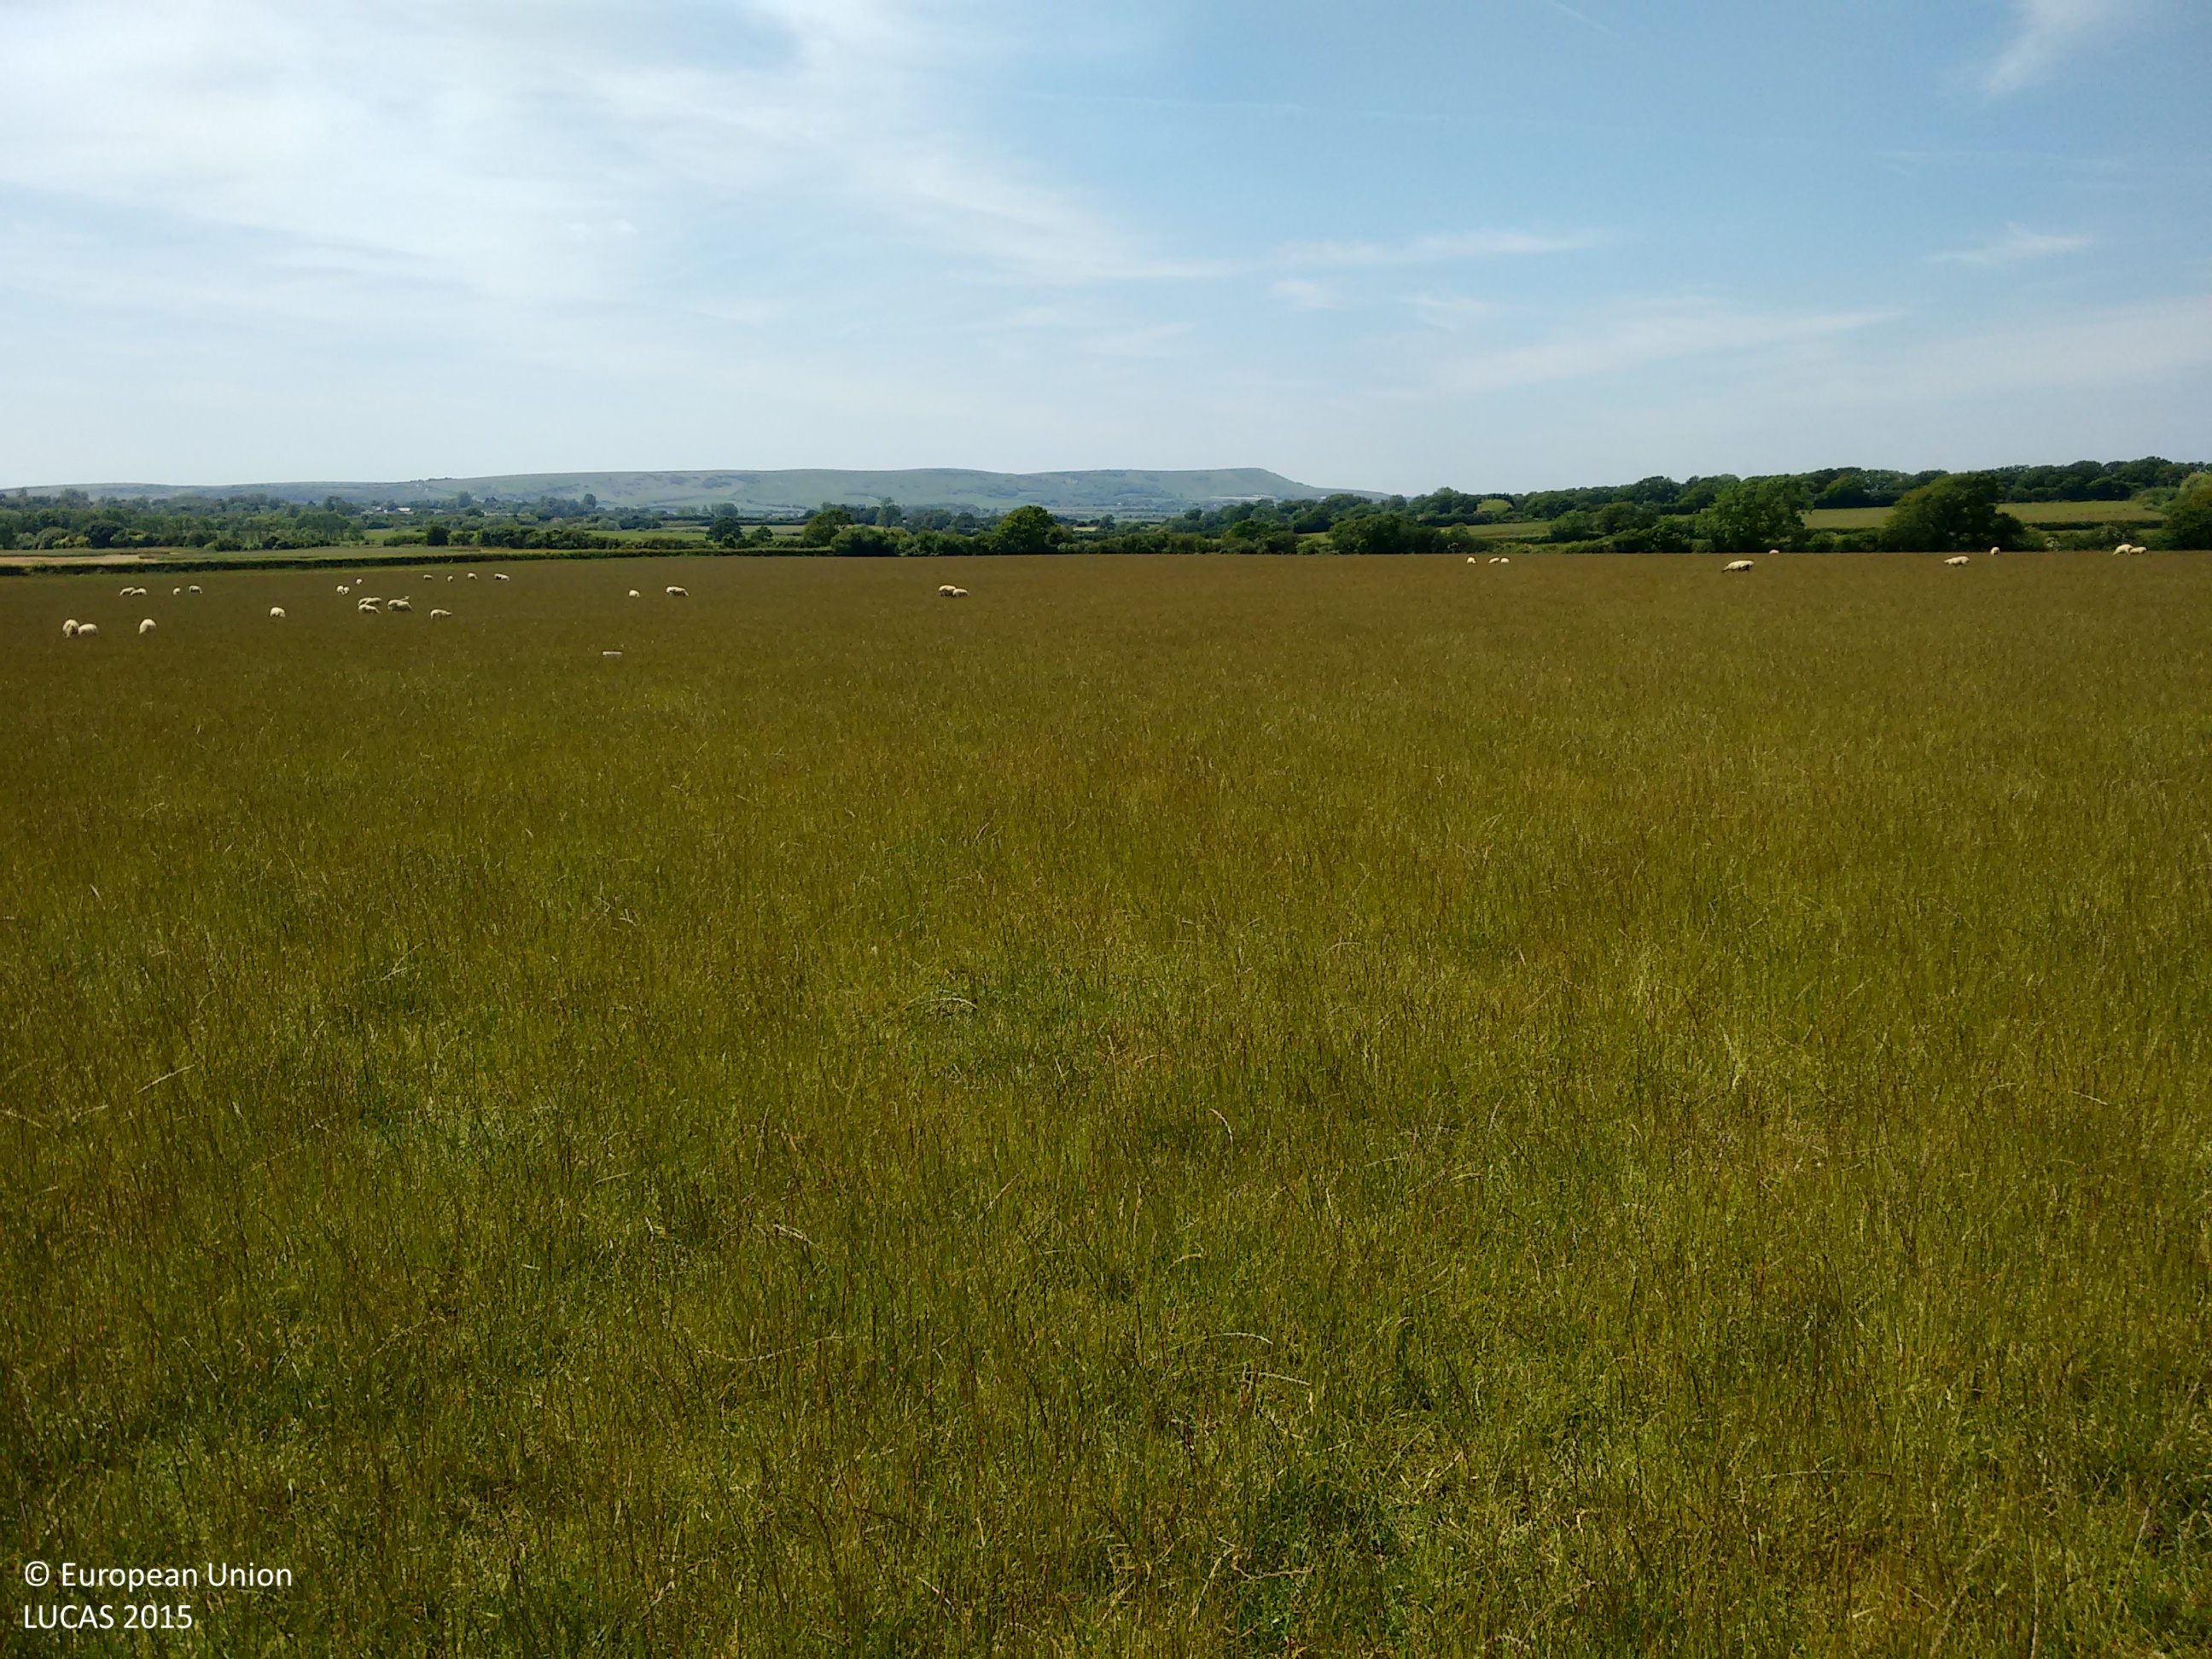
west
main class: Grassland
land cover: Grassland without tree/shrub cover
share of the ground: > 75 %
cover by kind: herbaceous plants 100 %
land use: Agriculture (excluding fallow land and kitchen gardens)
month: June
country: GB
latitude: 50.8312
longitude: 0.2154
